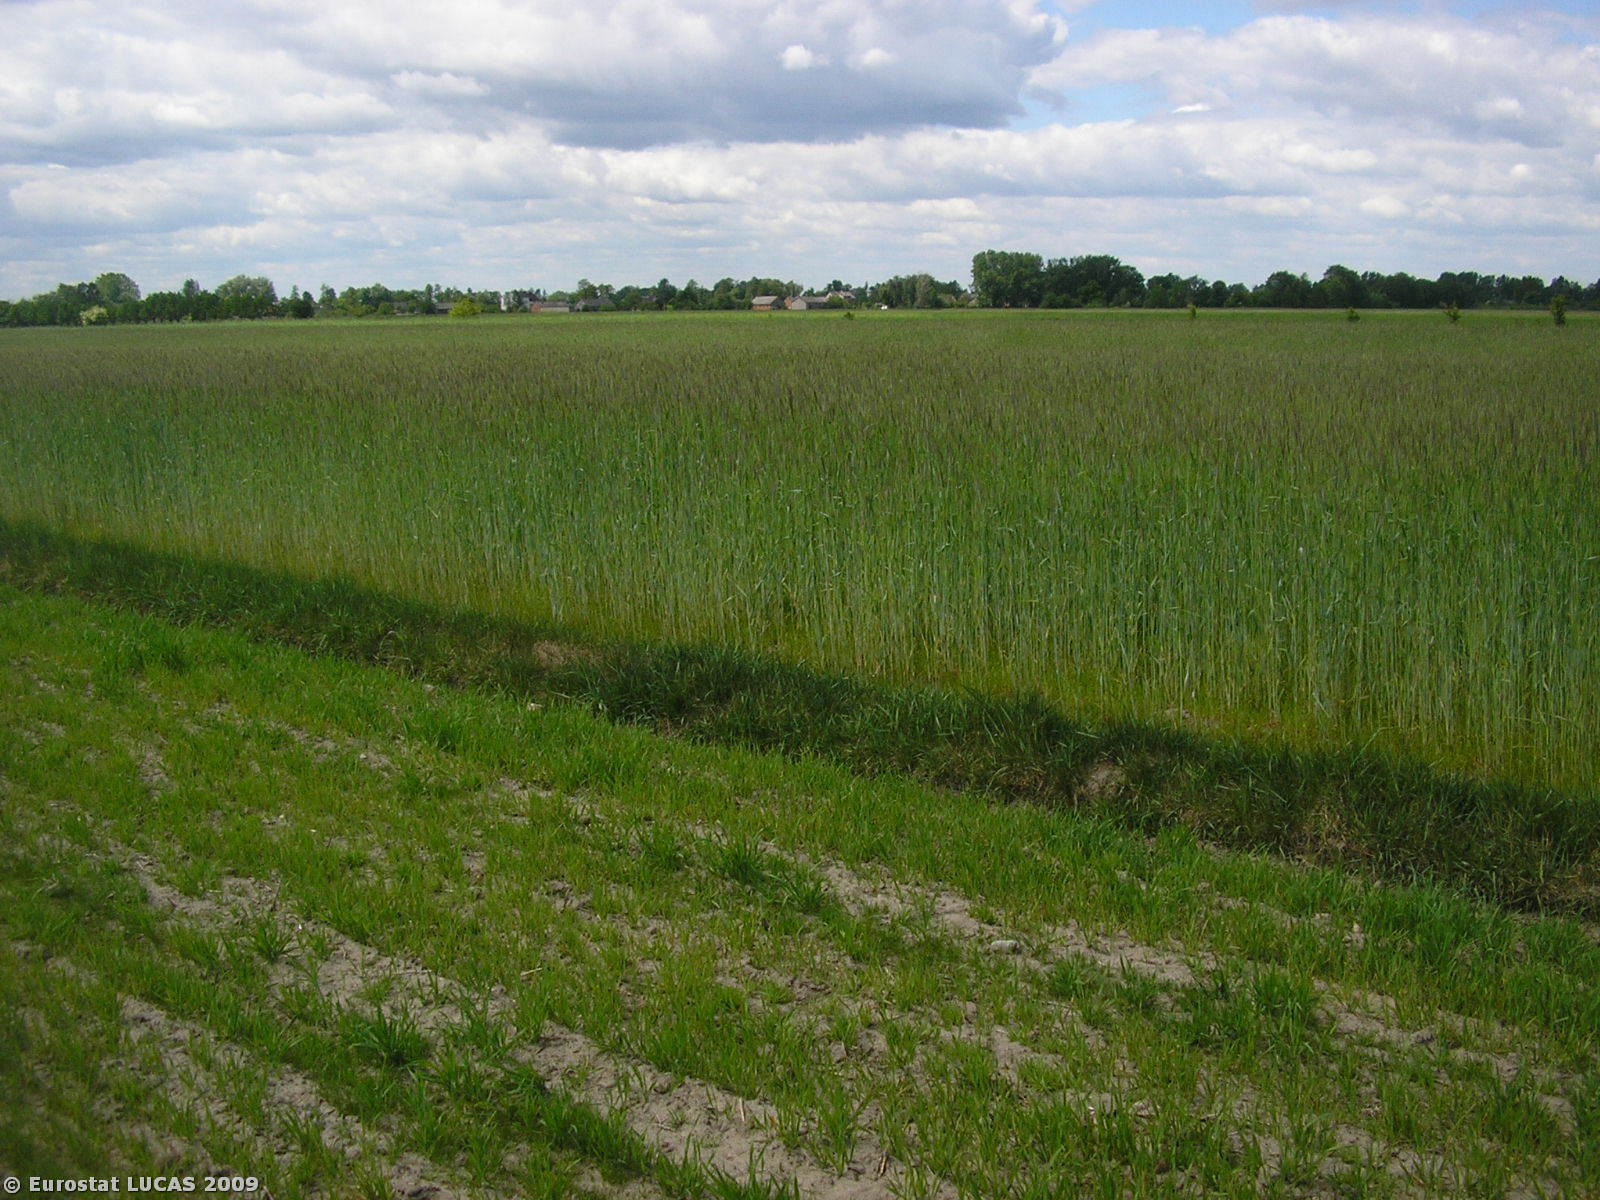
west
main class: Cropland
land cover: Oats
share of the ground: 10 - 25 %
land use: Agriculture (excluding fallow land and kitchen gardens)
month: May
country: PL
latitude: 51.9848
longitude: 20.0659
